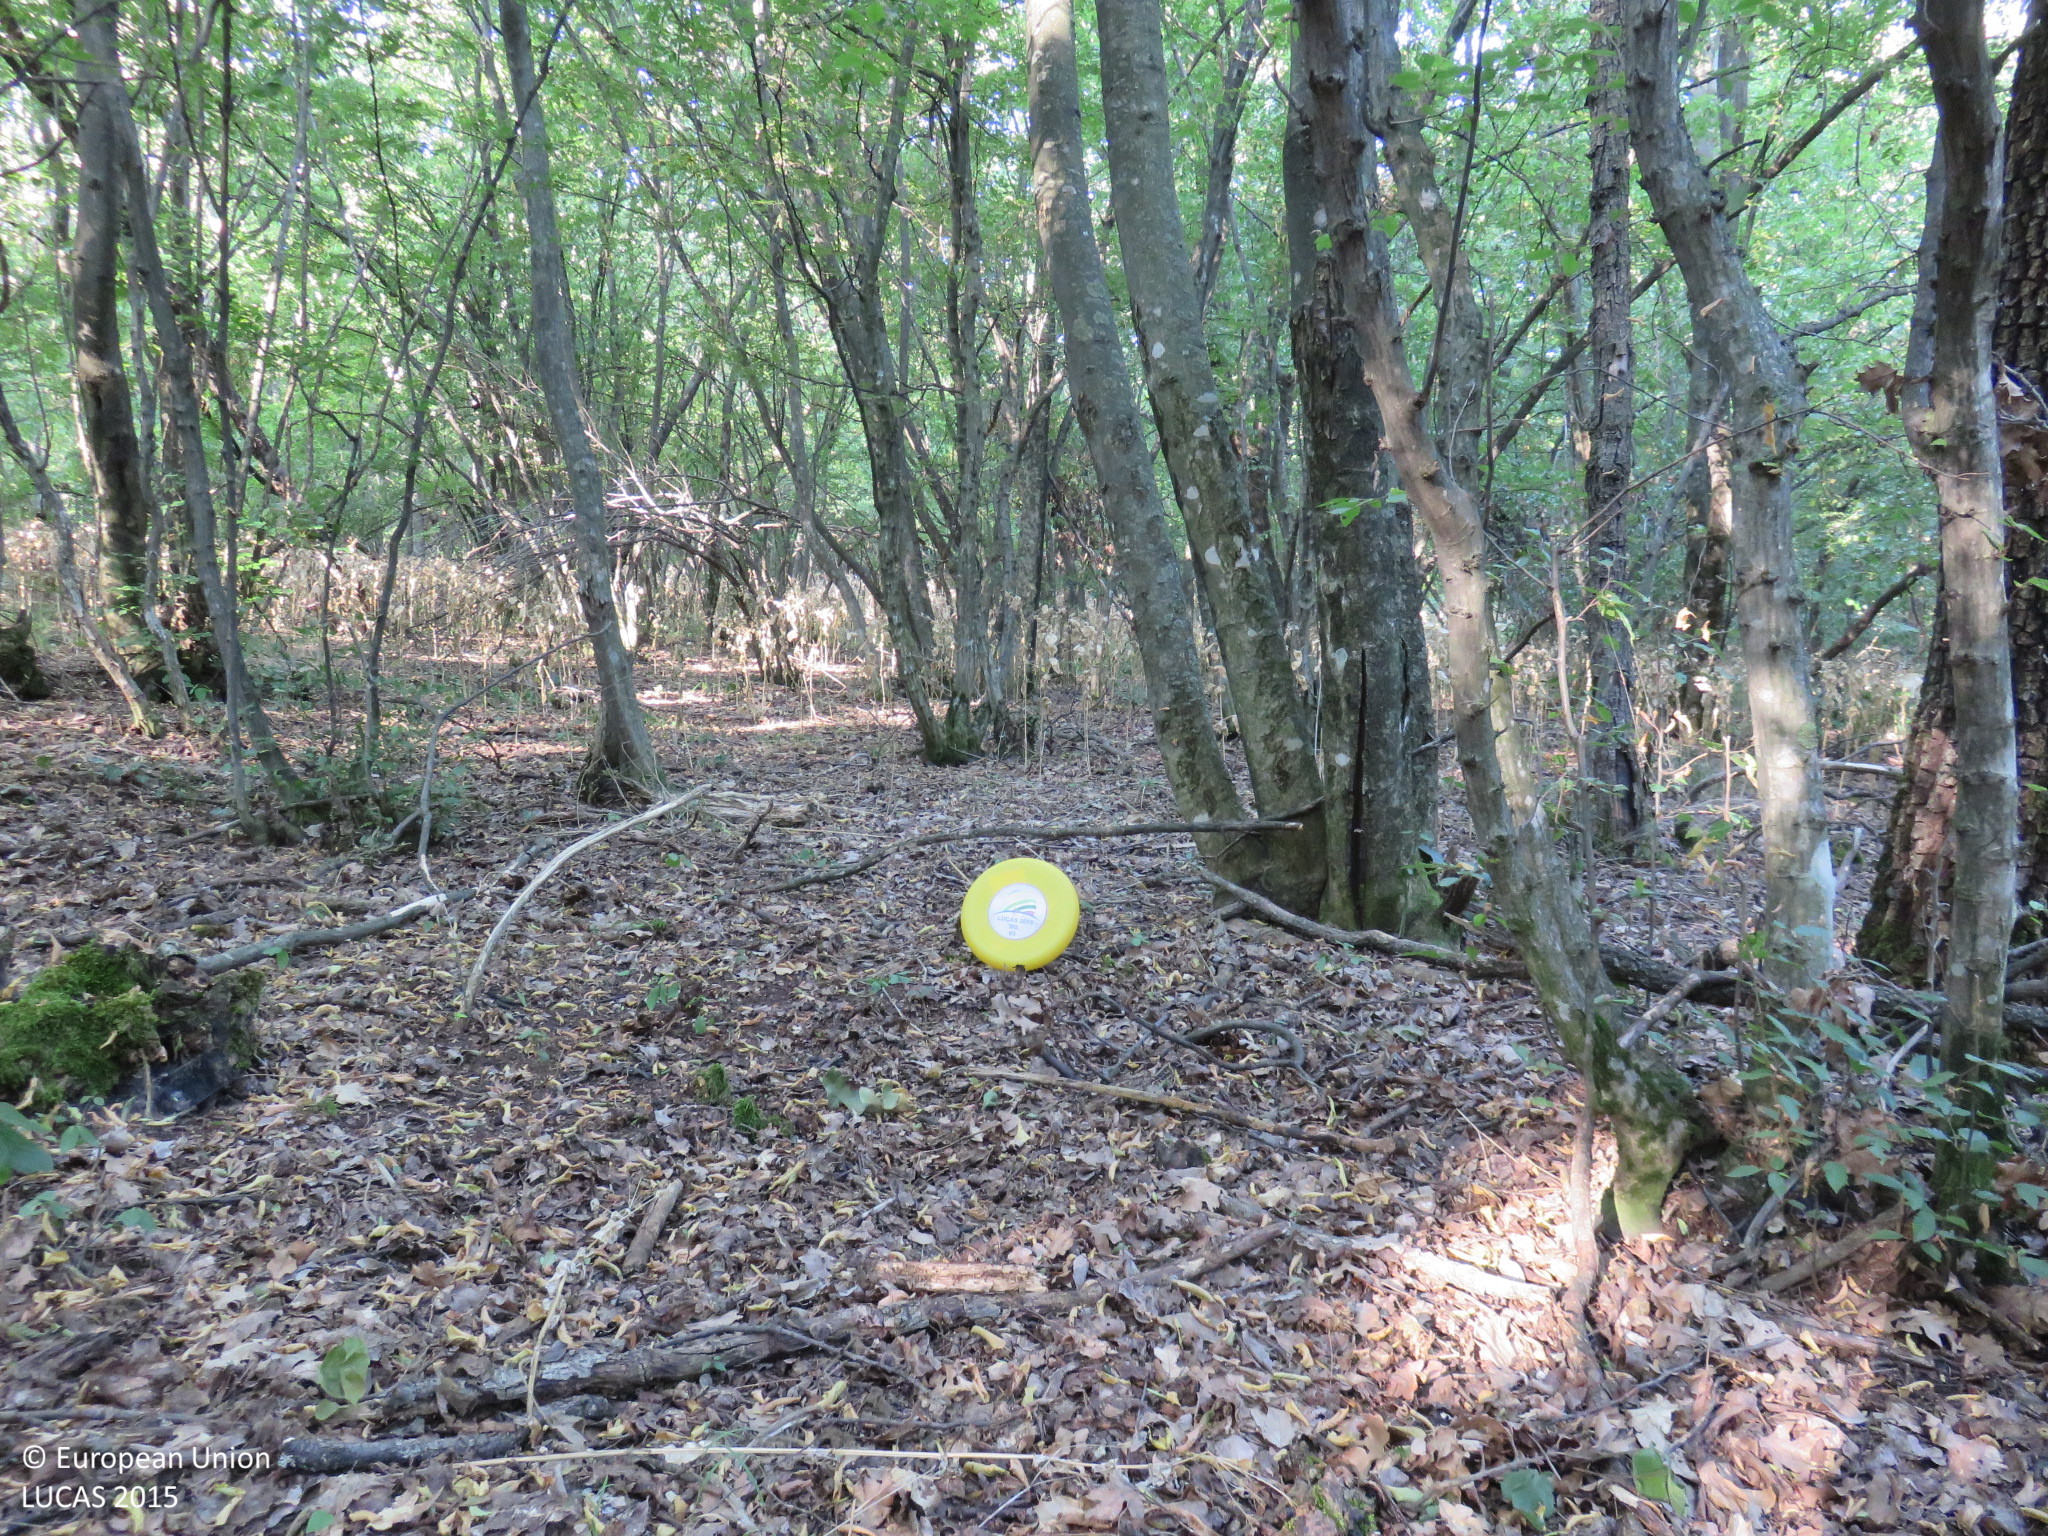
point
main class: Woodland
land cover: Broadleaved woodland
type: mesophytic deciduous forest
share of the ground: > 75 %
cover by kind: broadleaved forest trees 90 %, unconsolidated bare surface 10 %
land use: Forestry
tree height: < 5 m
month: July
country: BG
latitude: 43.2267
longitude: 25.0532
